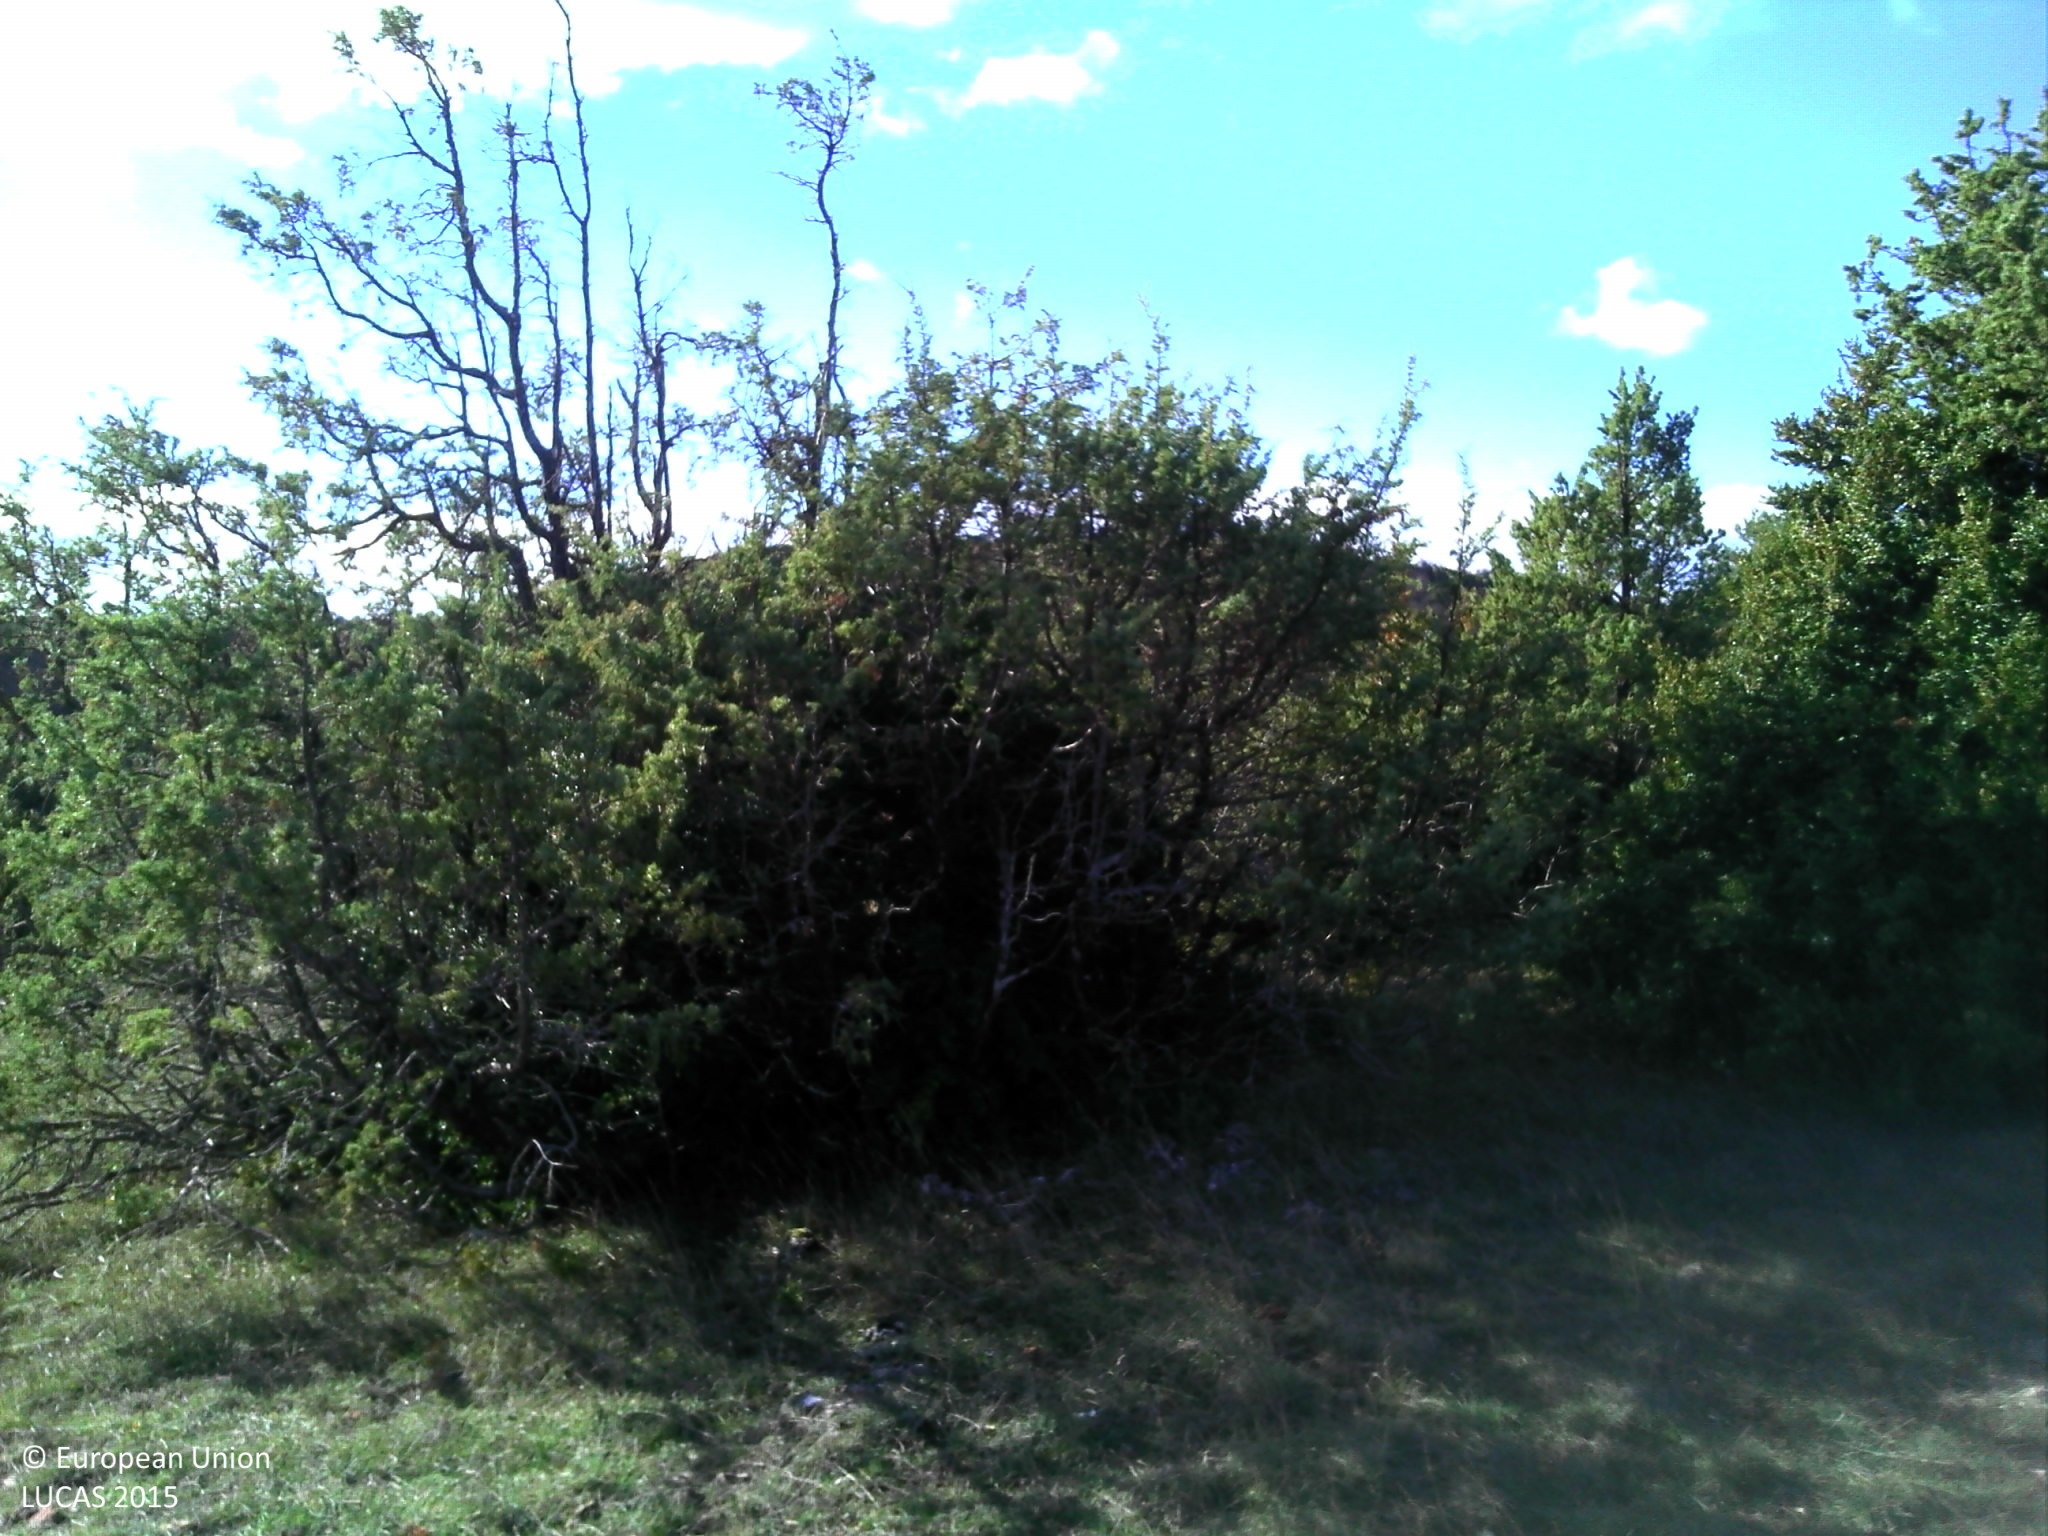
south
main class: Grassland
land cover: Grassland with sparse tree/shrub cover
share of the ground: > 75 %
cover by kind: herbaceous plants 90 %, coniferous forest trees 5 %, shrubs 5 %
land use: Agriculture (excluding fallow land and kitchen gardens)
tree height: < 5 m
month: November
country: FR
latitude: 43.9148
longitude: 3.2700
